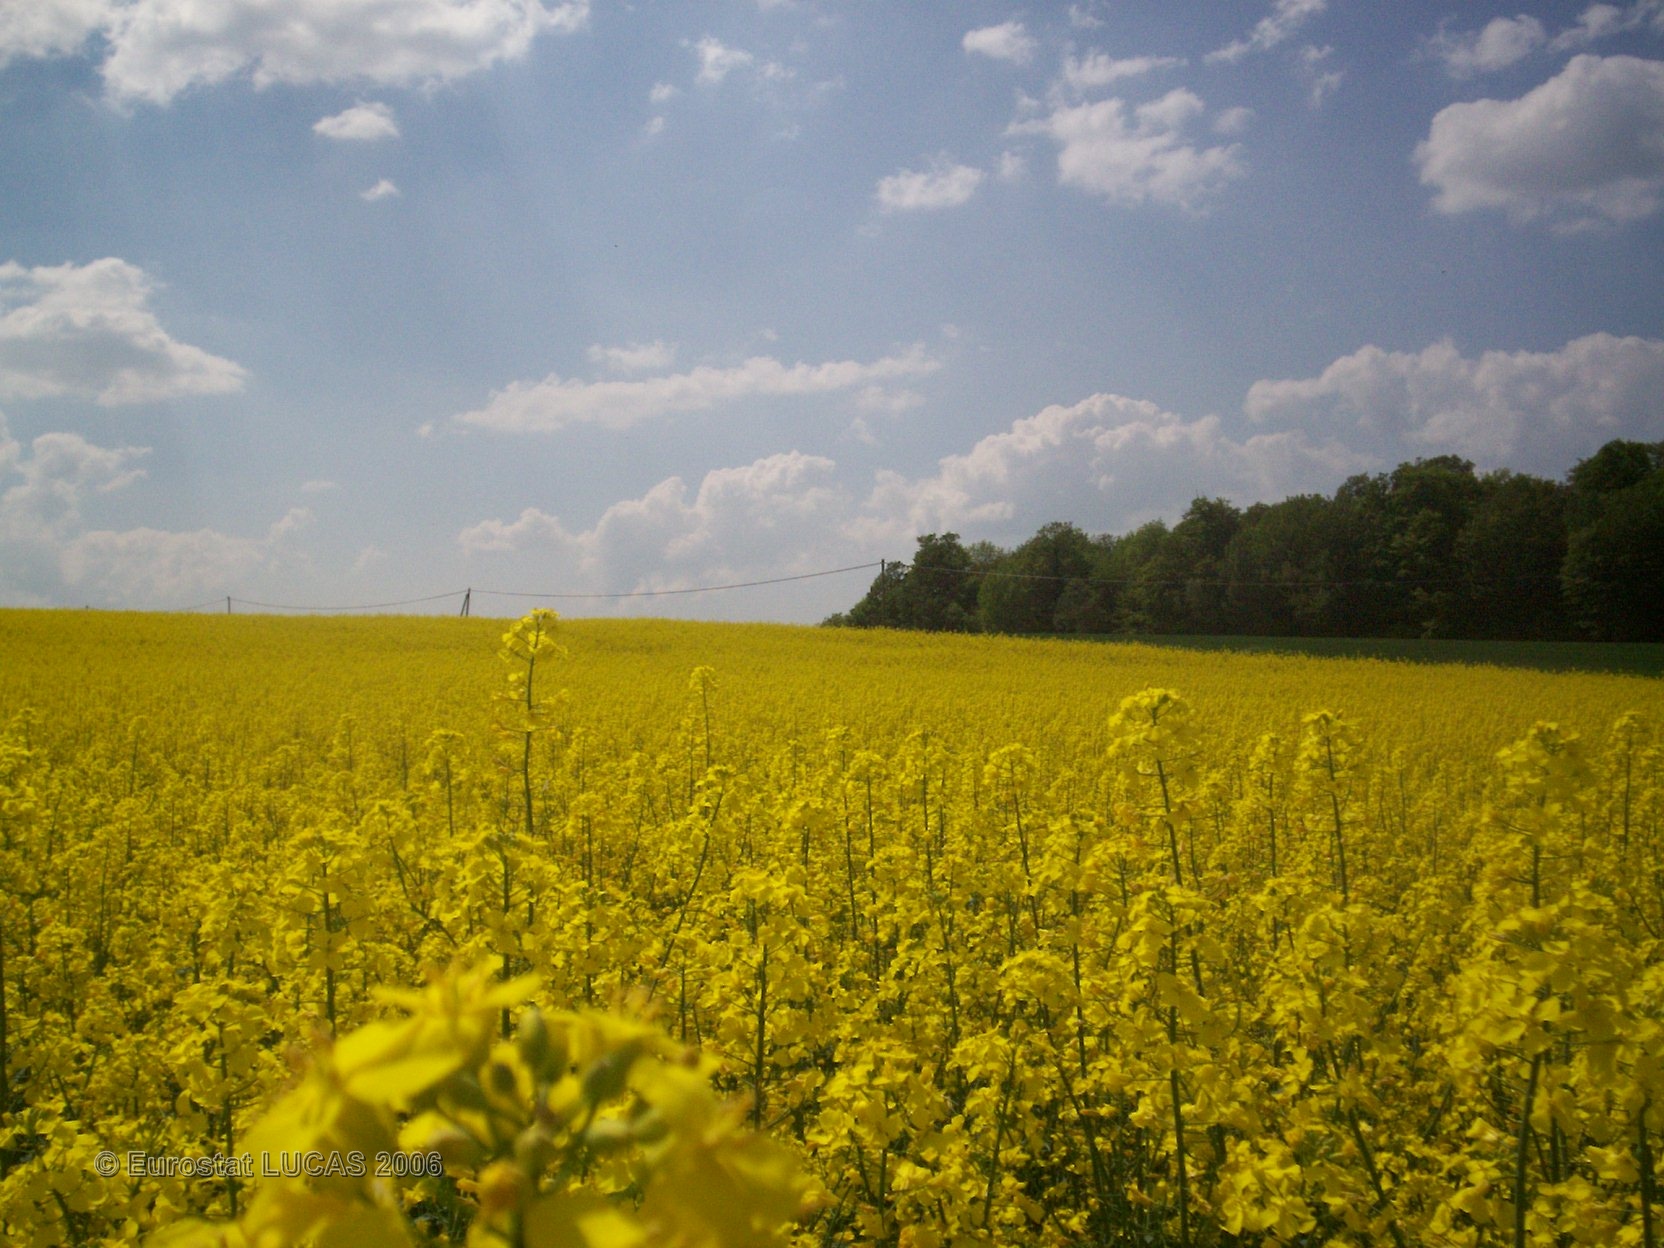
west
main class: Cropland
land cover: Rape and turnip rape
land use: Agriculture (excluding fallow land and kitchen gardens)
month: May
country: FR
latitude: 48.3572
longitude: 4.8834
